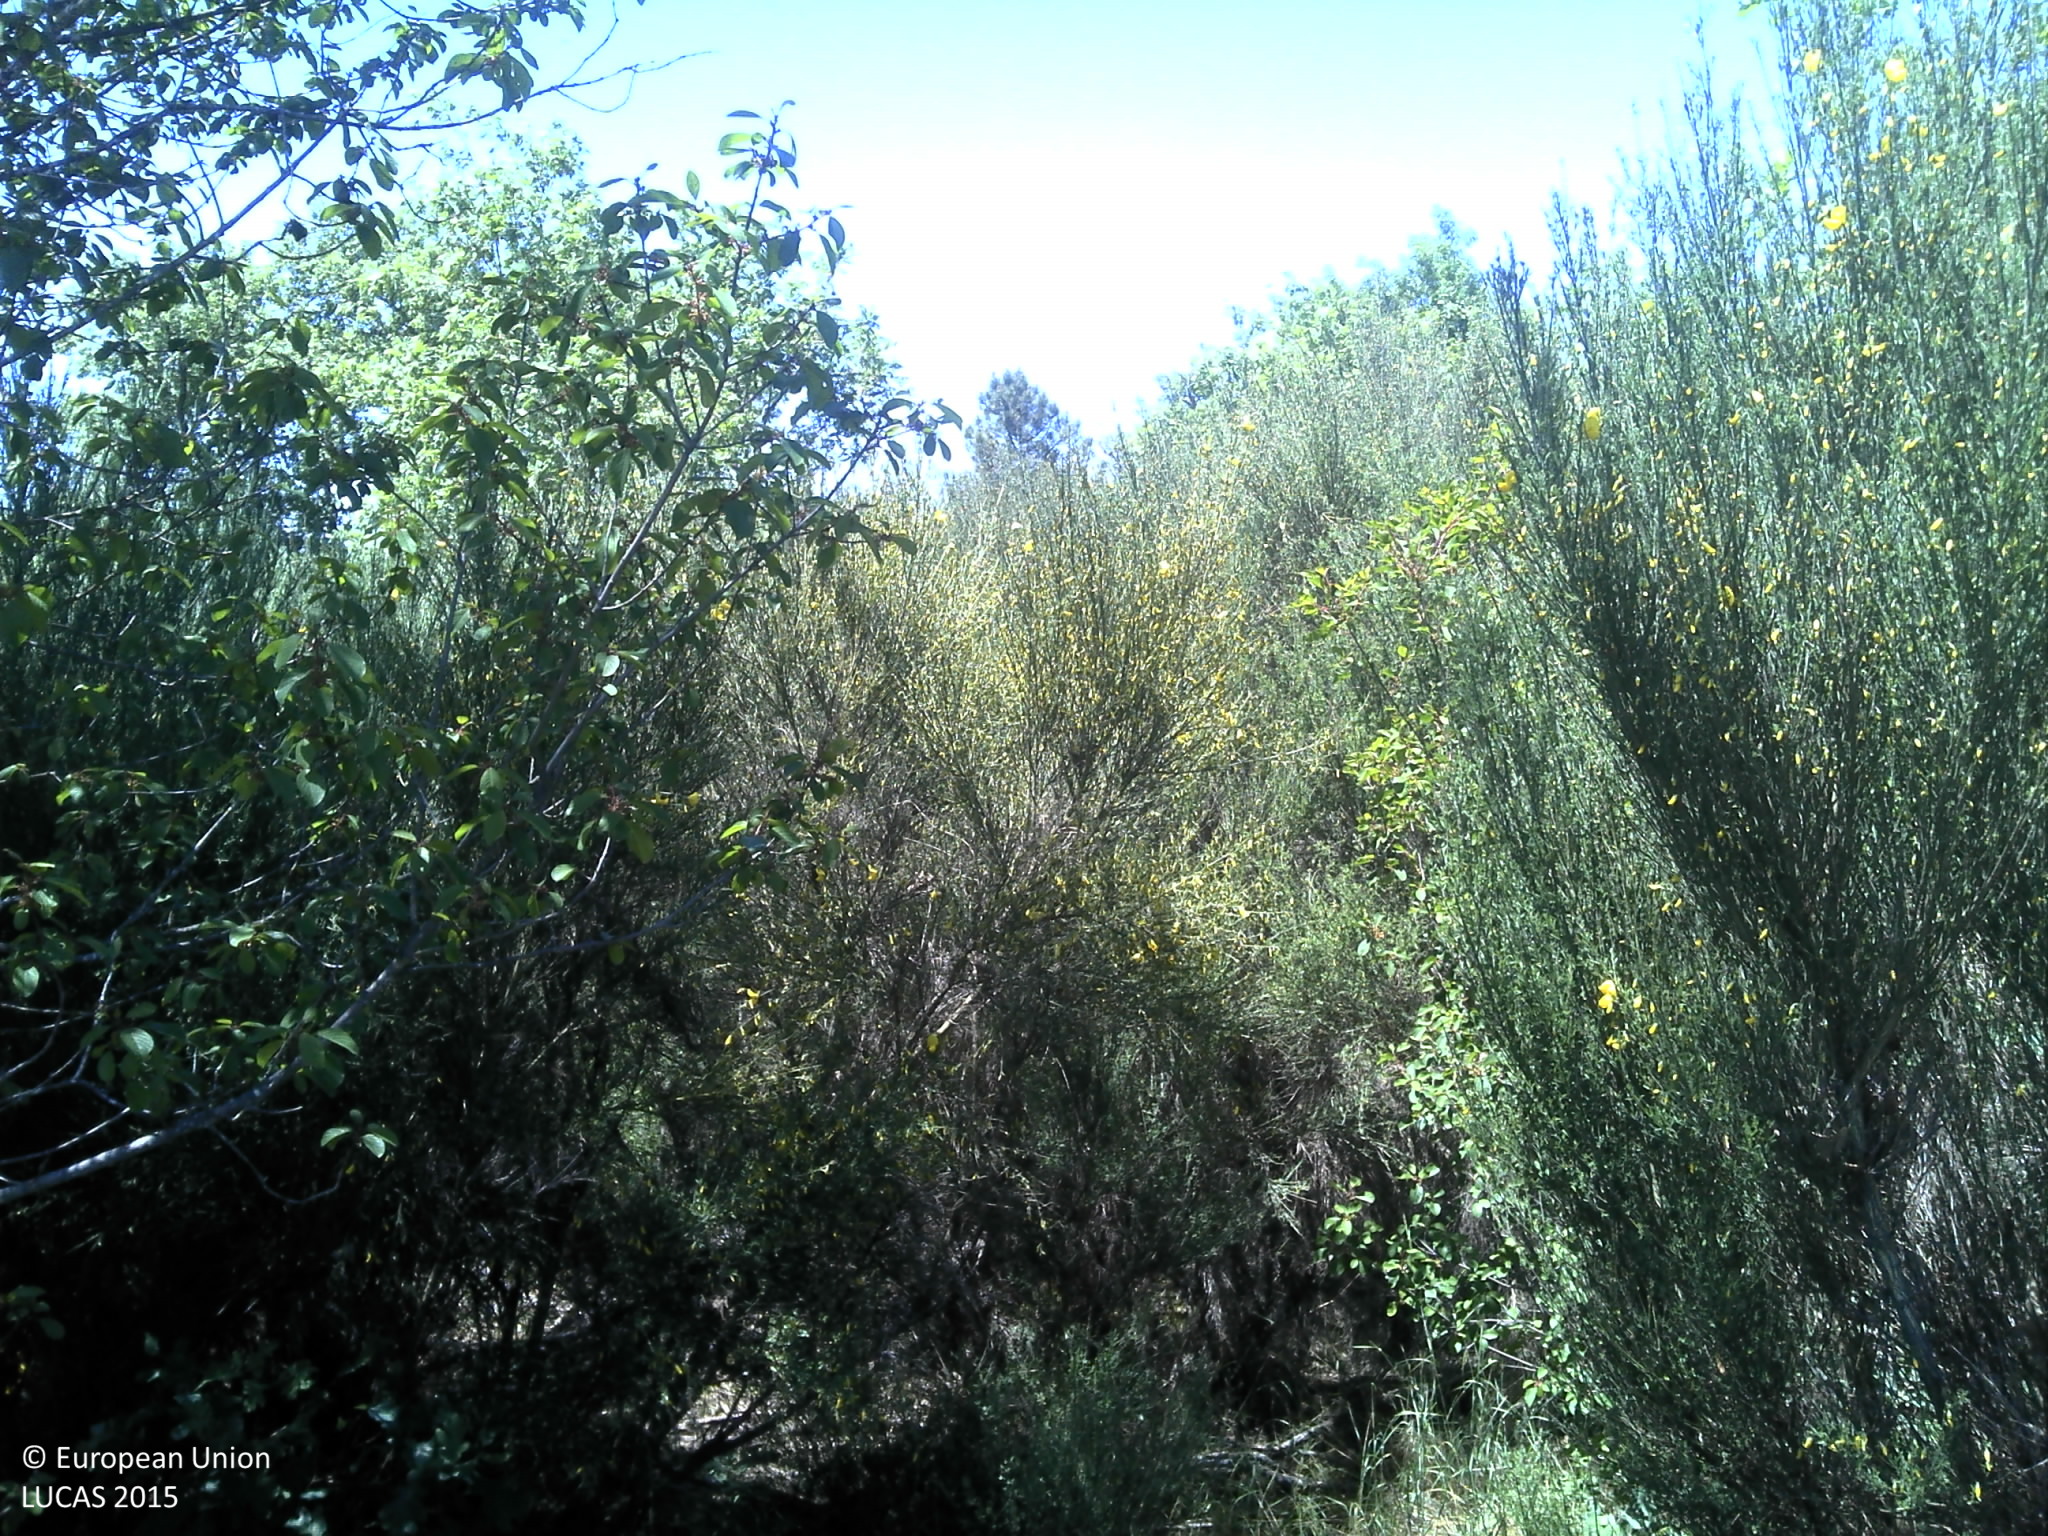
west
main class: Shrubland
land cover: Shrubland with sparse tree cover
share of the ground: 50 - 75 %
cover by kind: shrubs 65 %, herbaceous plants 15 %, unconsolidated bare surface 10 %, broadleaved forest trees 5 %
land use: Semi-natural and natural areas not in use
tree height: > 5 m
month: May
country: PT
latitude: 40.5664
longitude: -7.1715
